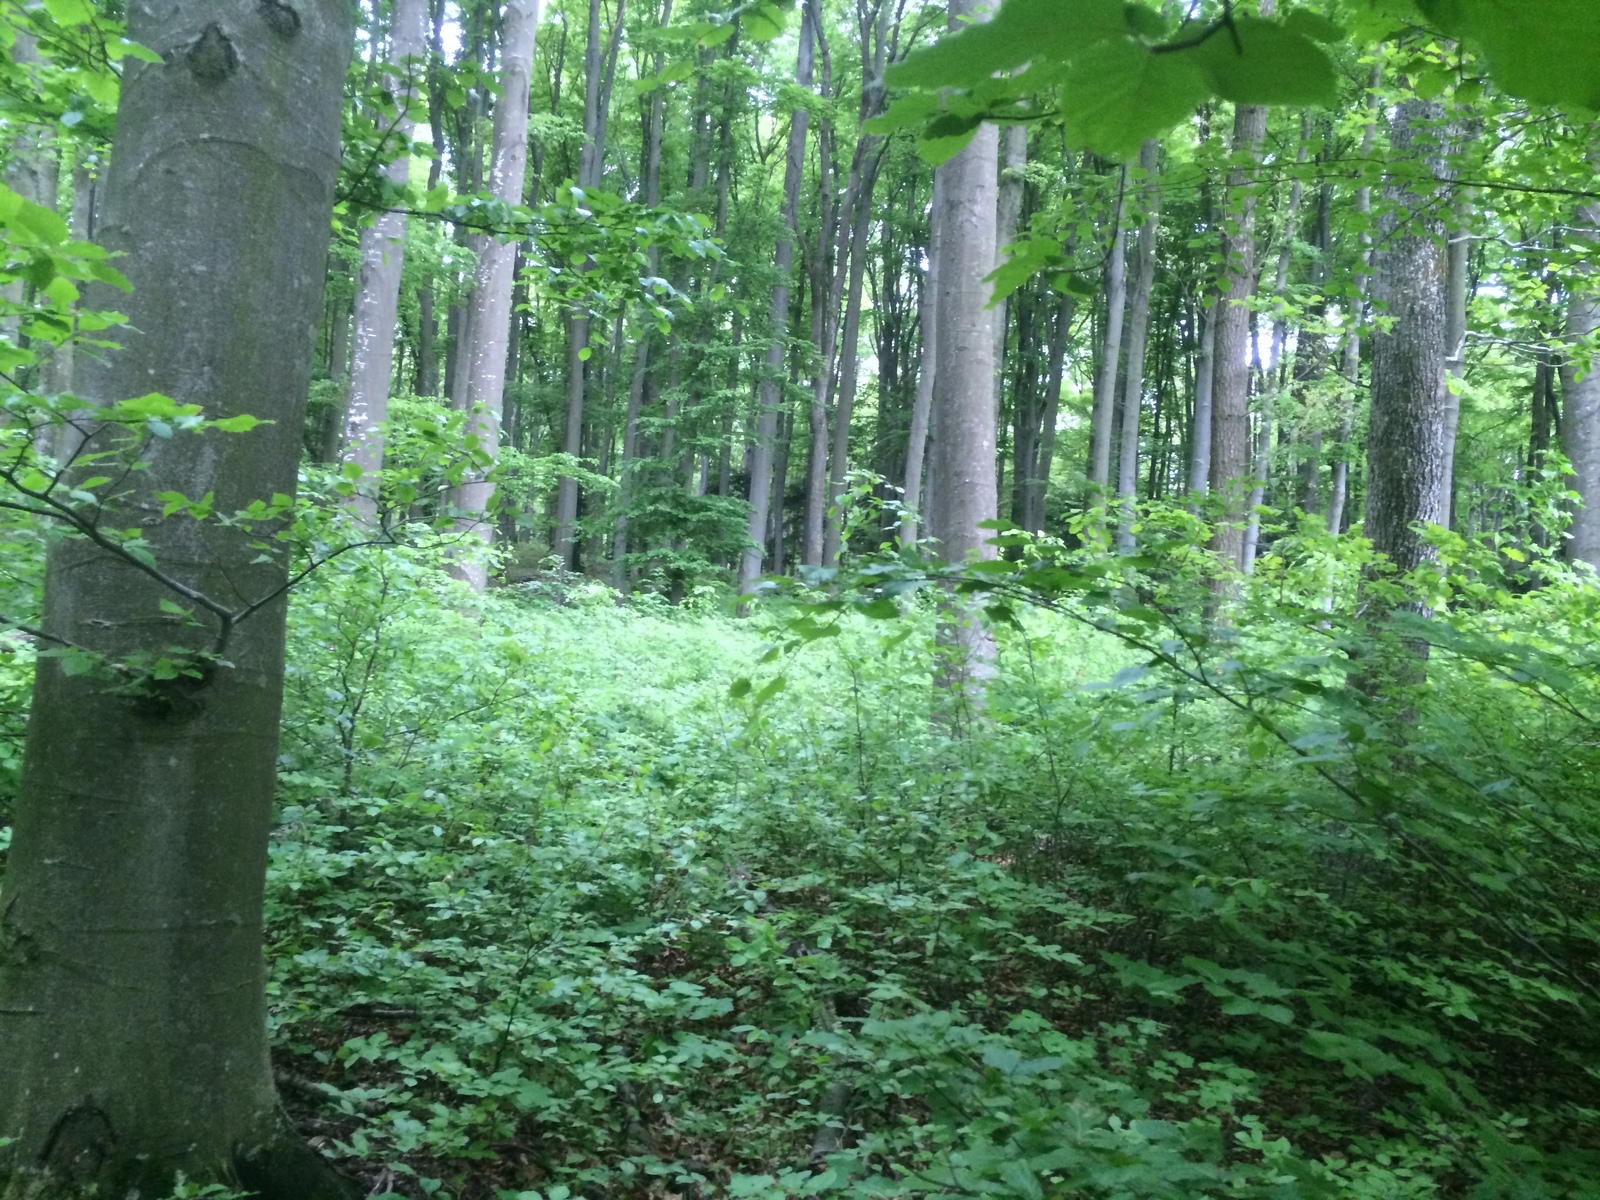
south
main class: Woodland
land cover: Broadleaved woodland
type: beech forest
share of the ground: > 75 %
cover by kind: broadleaved forest trees 100 %
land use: Forestry
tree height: > 5 m
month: May
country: AT
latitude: 48.0302
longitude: 16.2131
